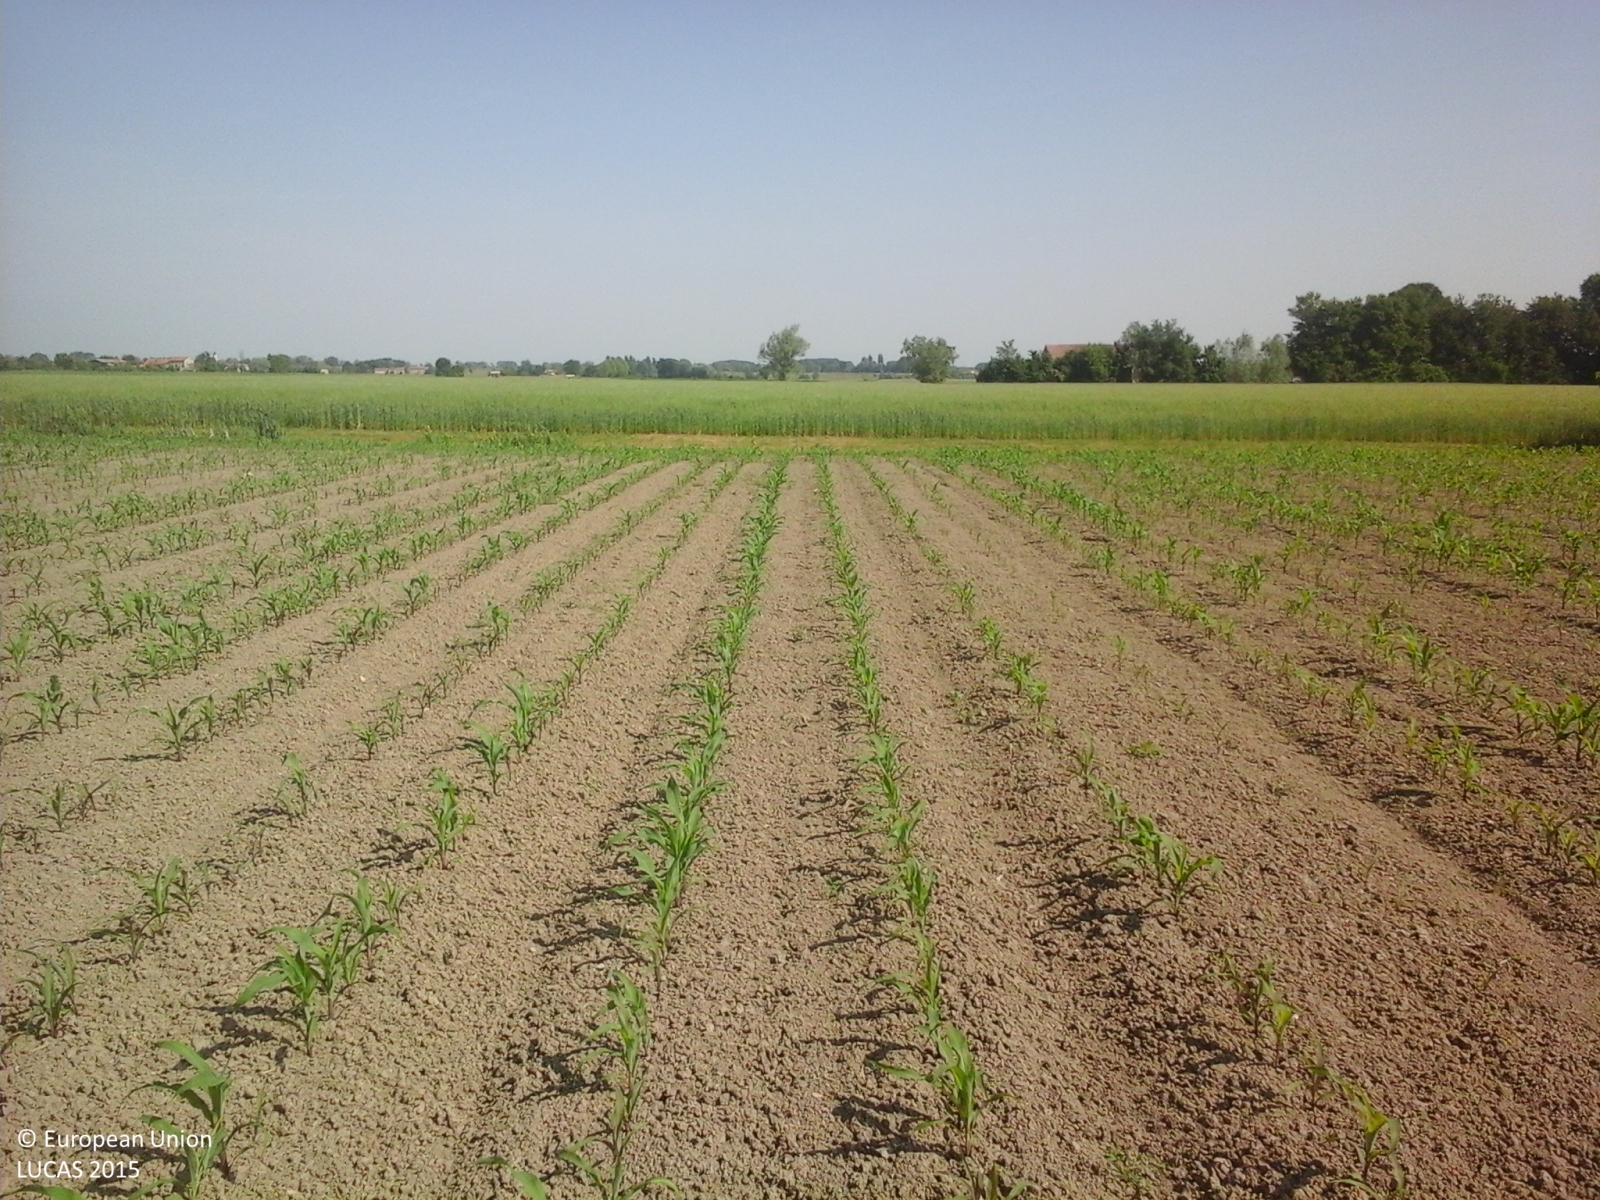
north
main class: Cropland
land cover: Maize
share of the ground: 10 - 25 %
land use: Agriculture (excluding fallow land and kitchen gardens)
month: May
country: IT
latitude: 45.0493
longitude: 10.9758
